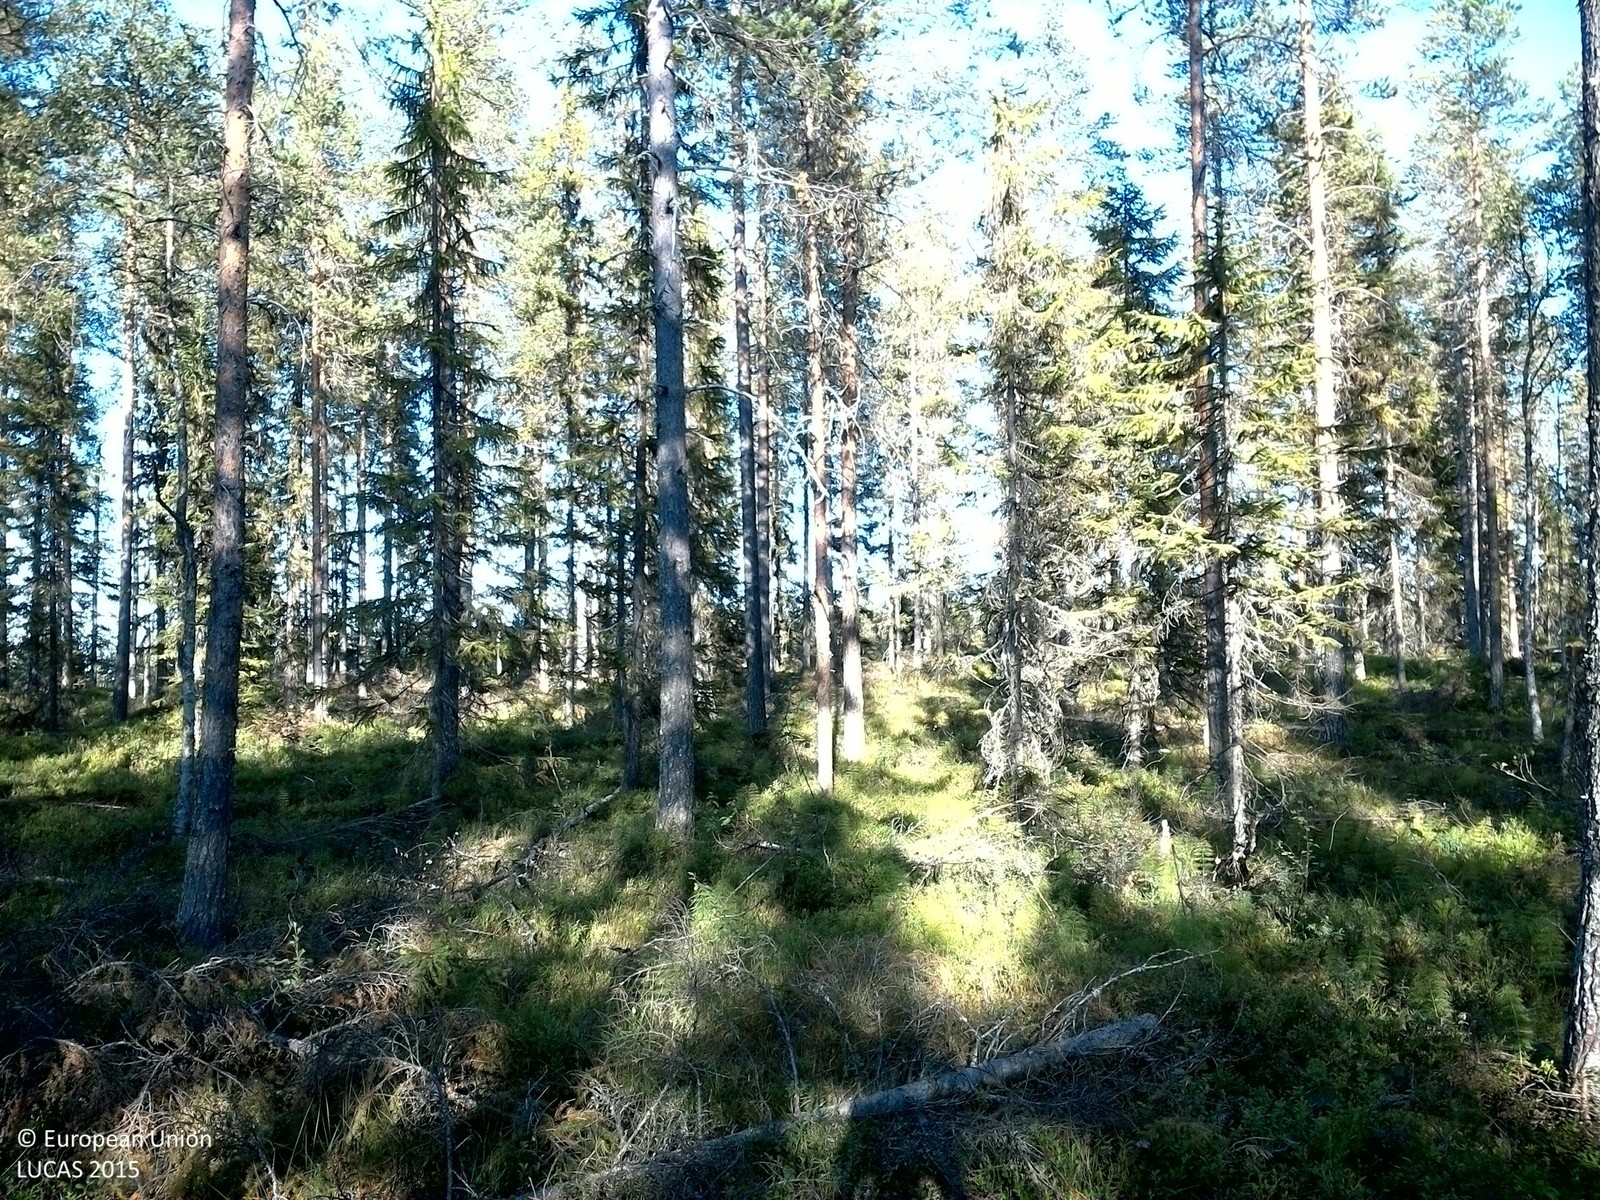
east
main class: Woodland
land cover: Pine dominated coniferous woodland
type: boreal forest
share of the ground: 50 - 75 %
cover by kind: coniferous forest trees 60 %, shrubs 25 %, broadleaved forest trees 5 %, herbaceous plants 5 %, lichens and mosses 5 %
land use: Forestry
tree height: > 5 m
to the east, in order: Pine dominated coniferous woodland; Spruce dominated coniferous woodland; Spruce dominated mixed woodland
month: August
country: SE
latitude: 63.6918
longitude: 17.5566
